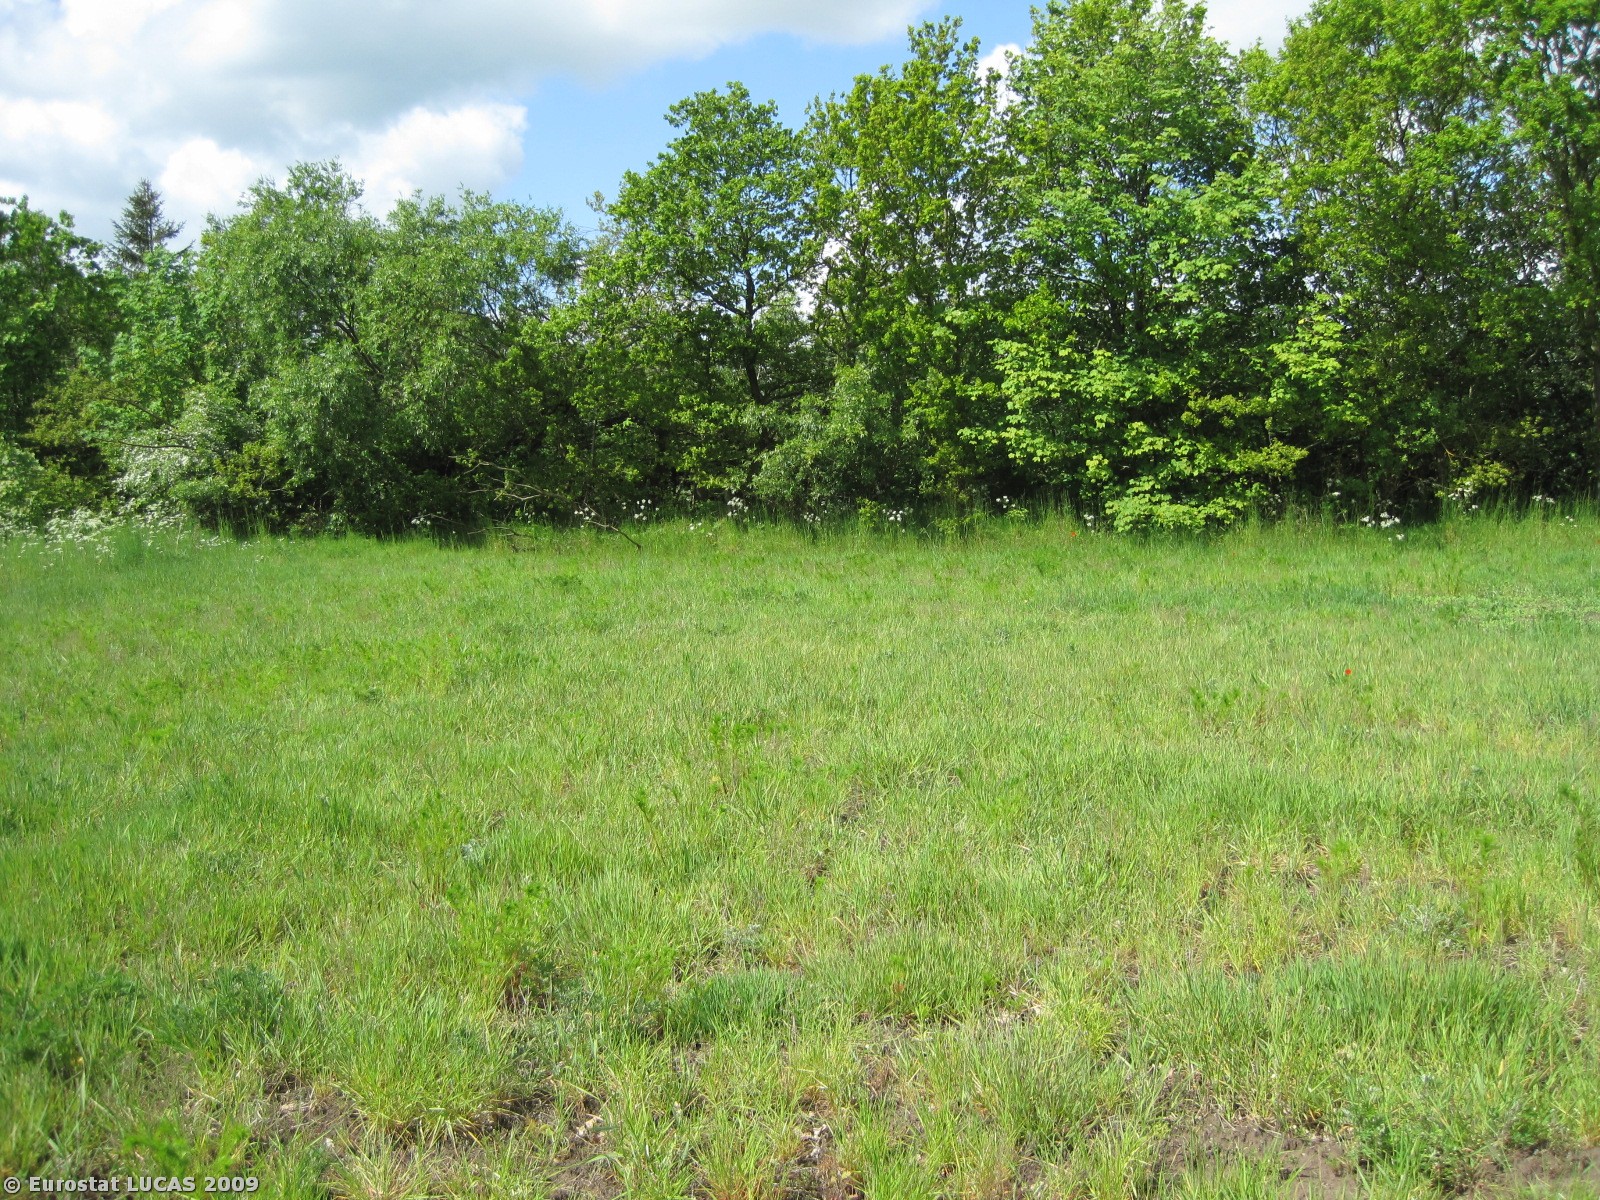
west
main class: Grassland
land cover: Grassland without tree/shrub cover
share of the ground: > 75 %
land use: Agriculture (excluding fallow land and kitchen gardens)
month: May
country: DK
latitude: 56.5471
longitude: 9.7888
